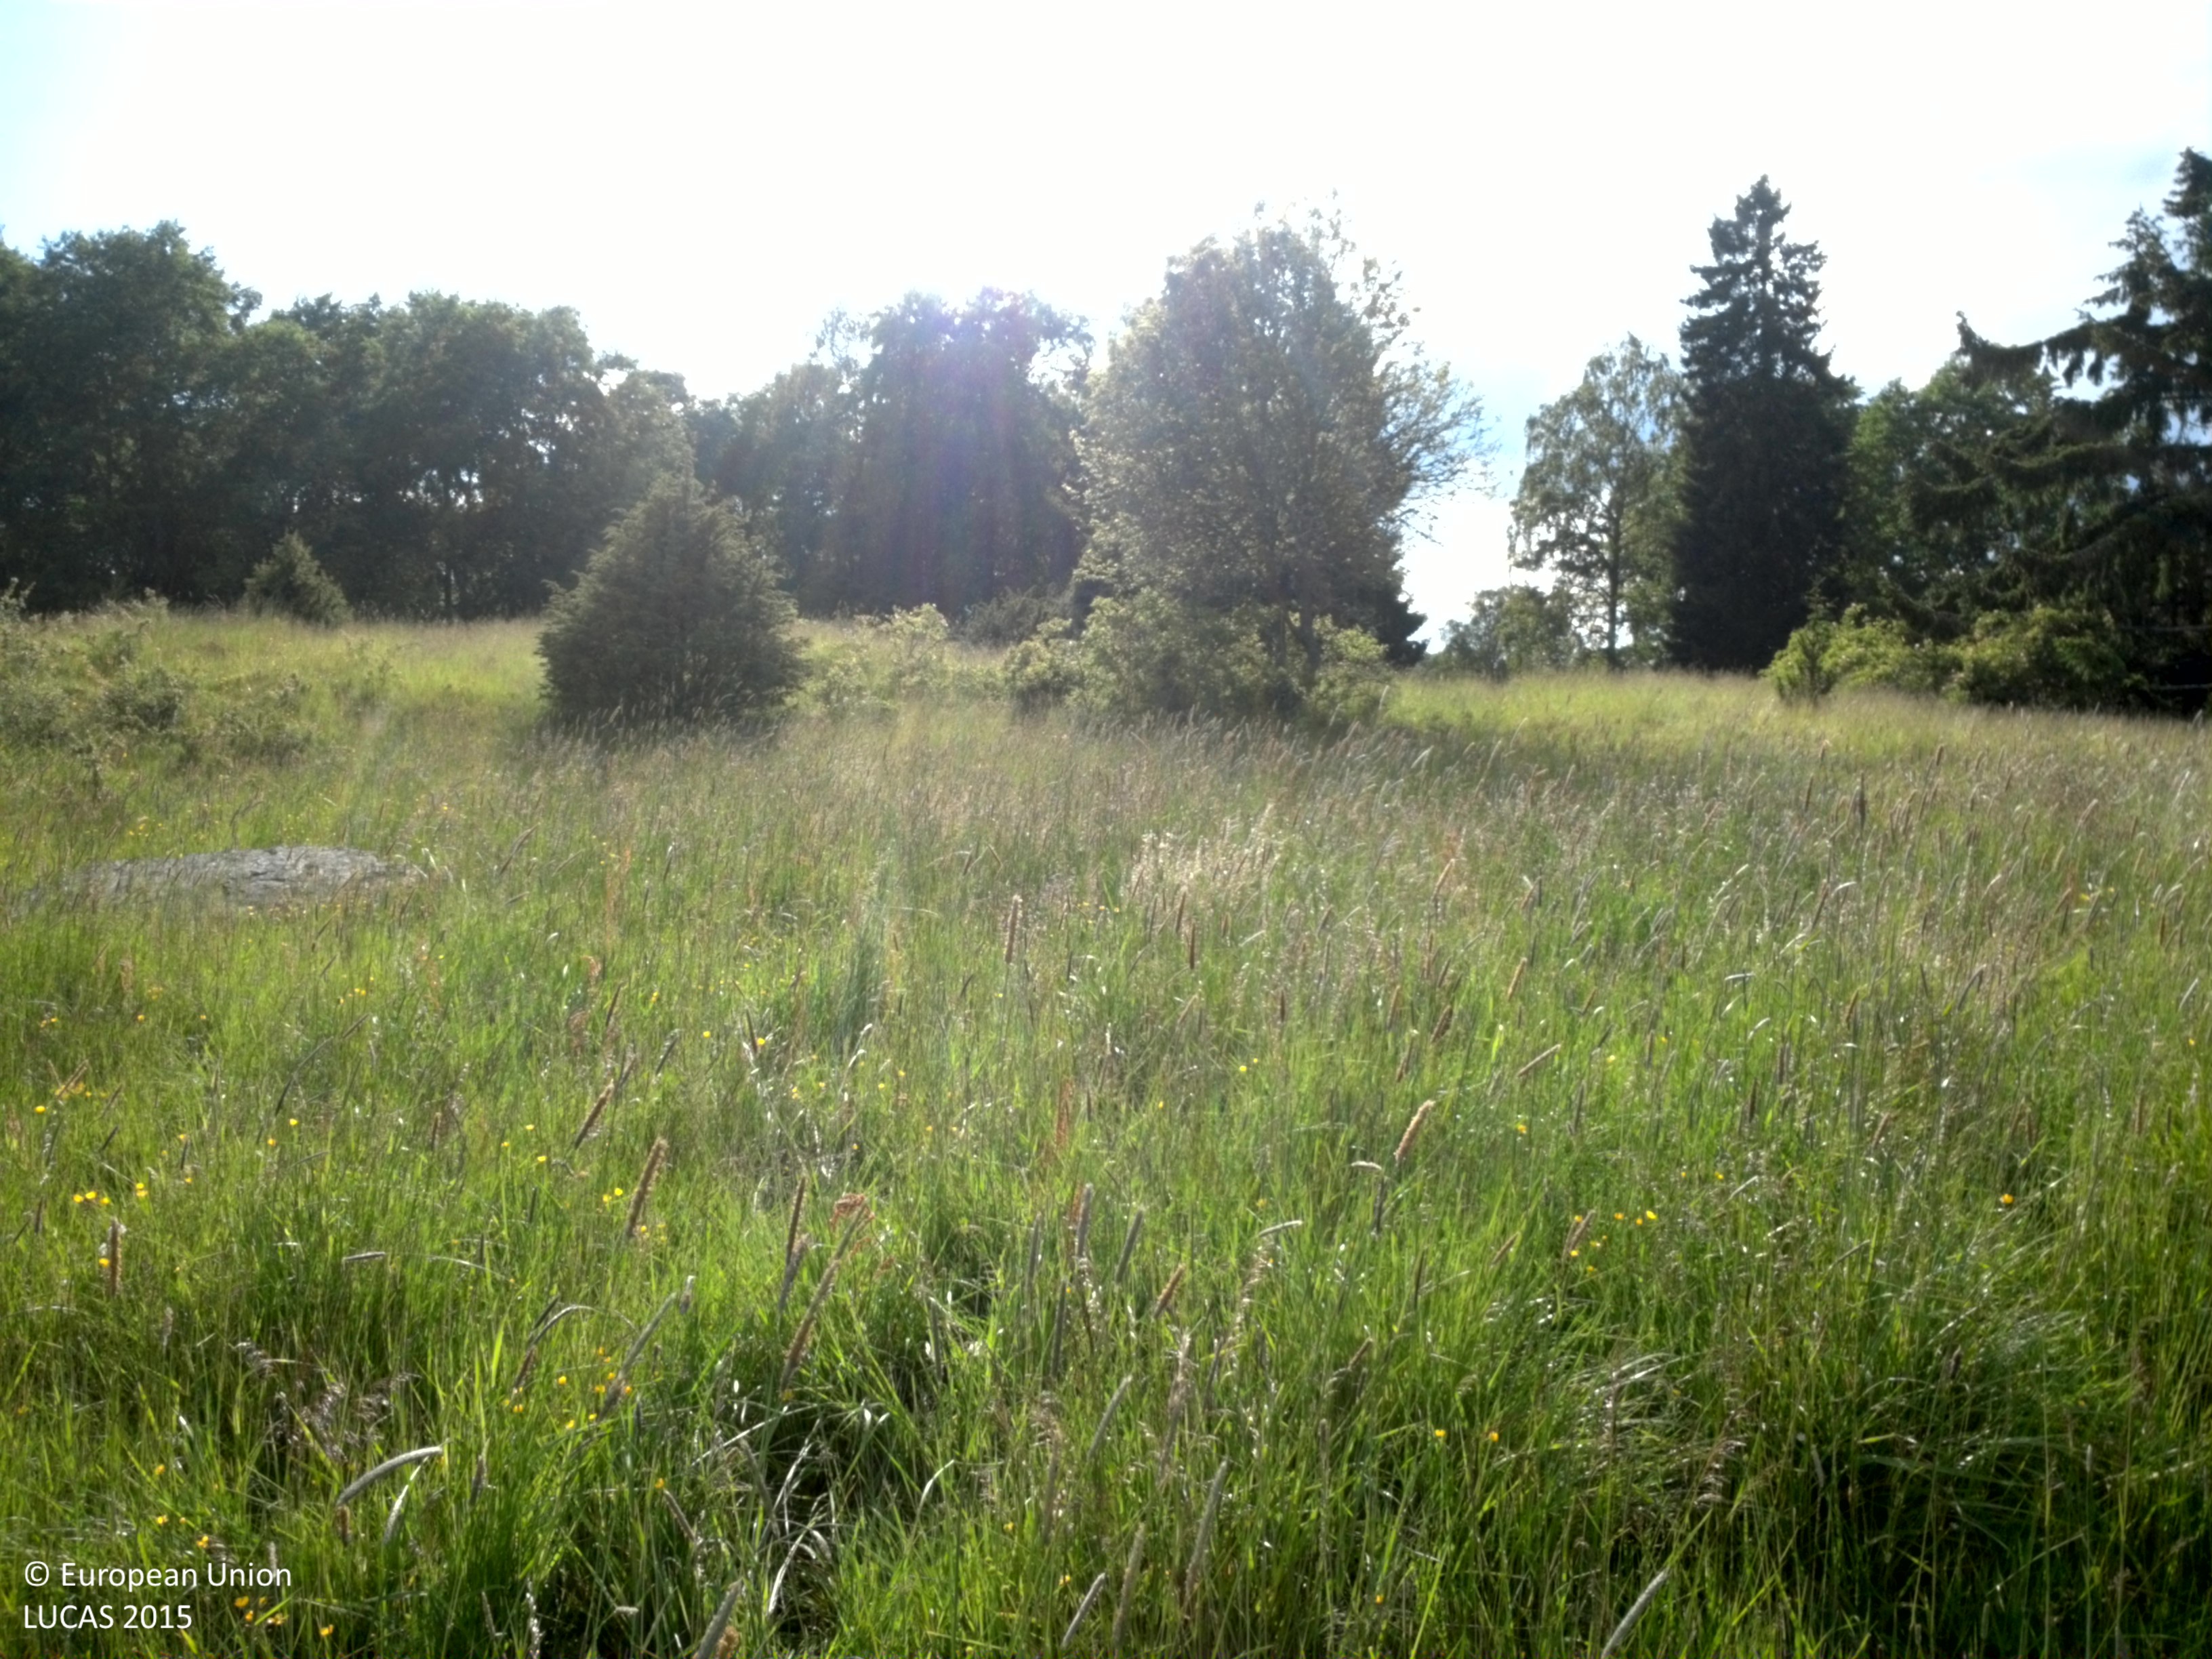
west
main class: Grassland
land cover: Grassland with sparse tree/shrub cover
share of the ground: 10 - 25 %
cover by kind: herbaceous plants 80 %, lichens and mosses 10 %, coniferous forest trees 5 %, shrubs 5 %
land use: Agriculture (excluding fallow land and kitchen gardens)
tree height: > 5 m
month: June
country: SE
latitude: 59.7431
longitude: 17.8779
